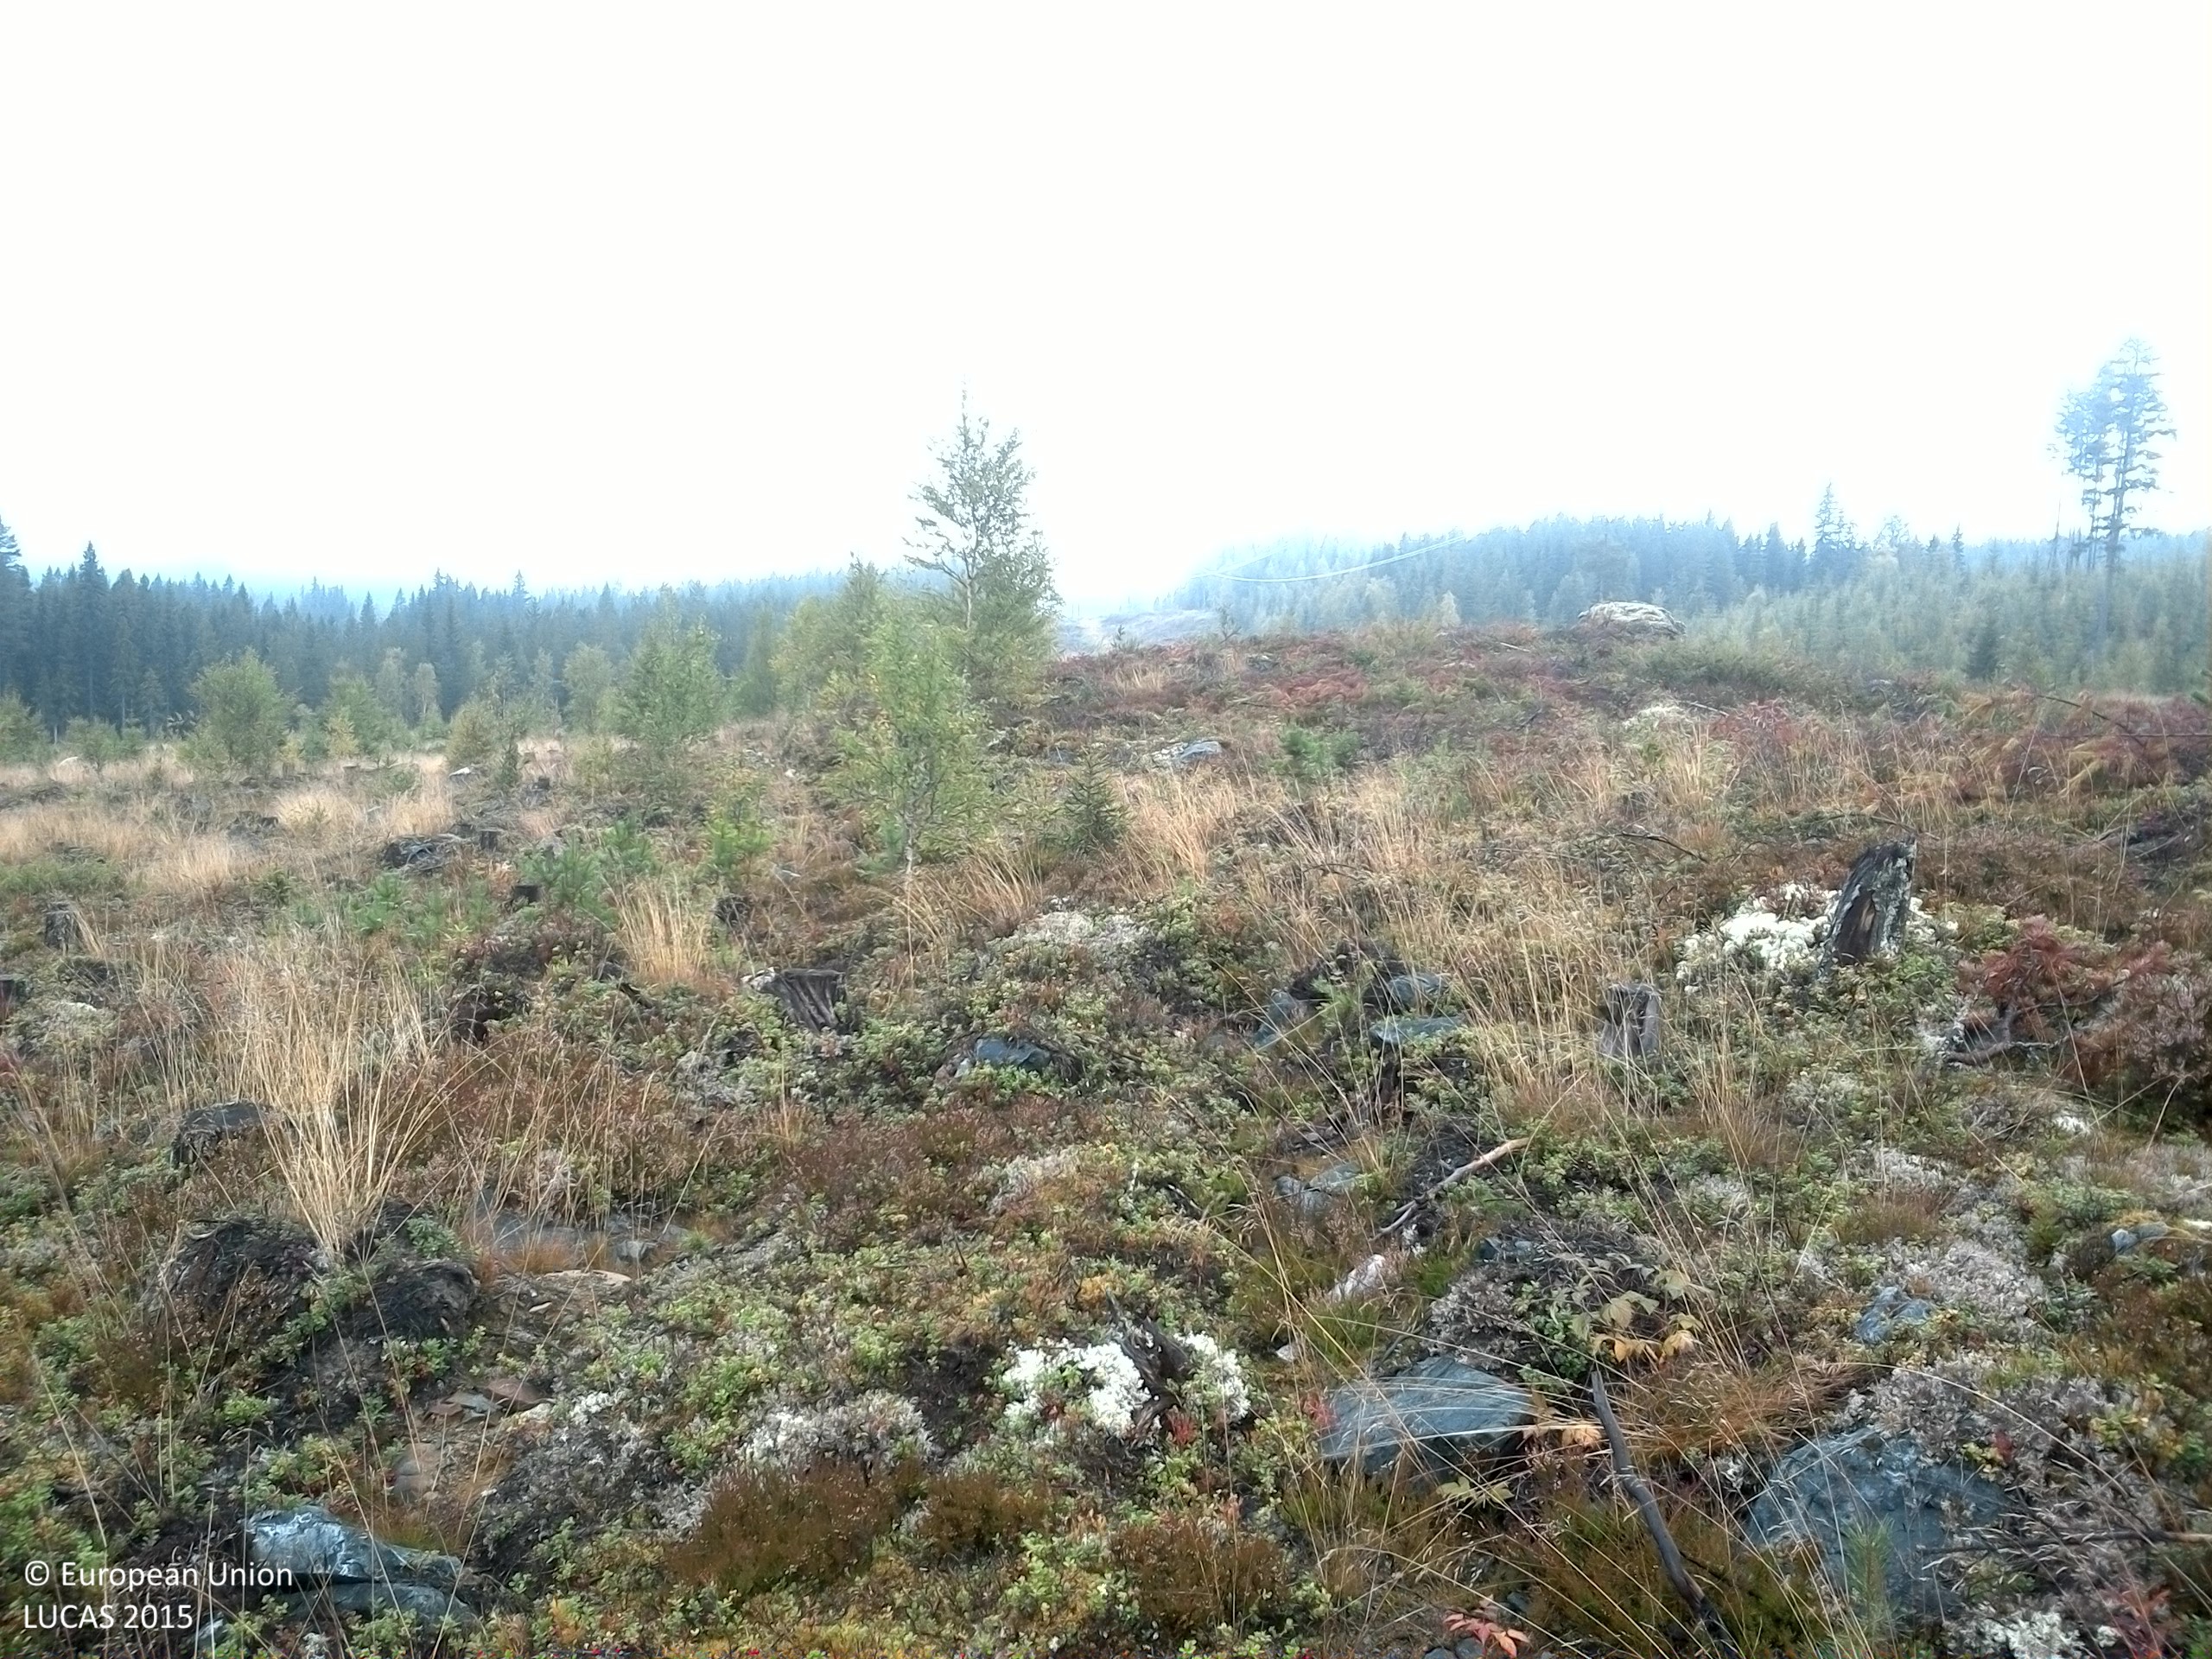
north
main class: Shrubland
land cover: Shrubland with sparse tree cover
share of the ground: > 75 %
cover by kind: shrubs 70 %, lichens and mosses 10 %, consolidated bare surface 10 %, coniferous forest trees 5 %, herbaceous plants 5 %
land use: Forestry
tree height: < 5 m
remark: Clear cut
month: September
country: SE
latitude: 61.6742
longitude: 15.1789
